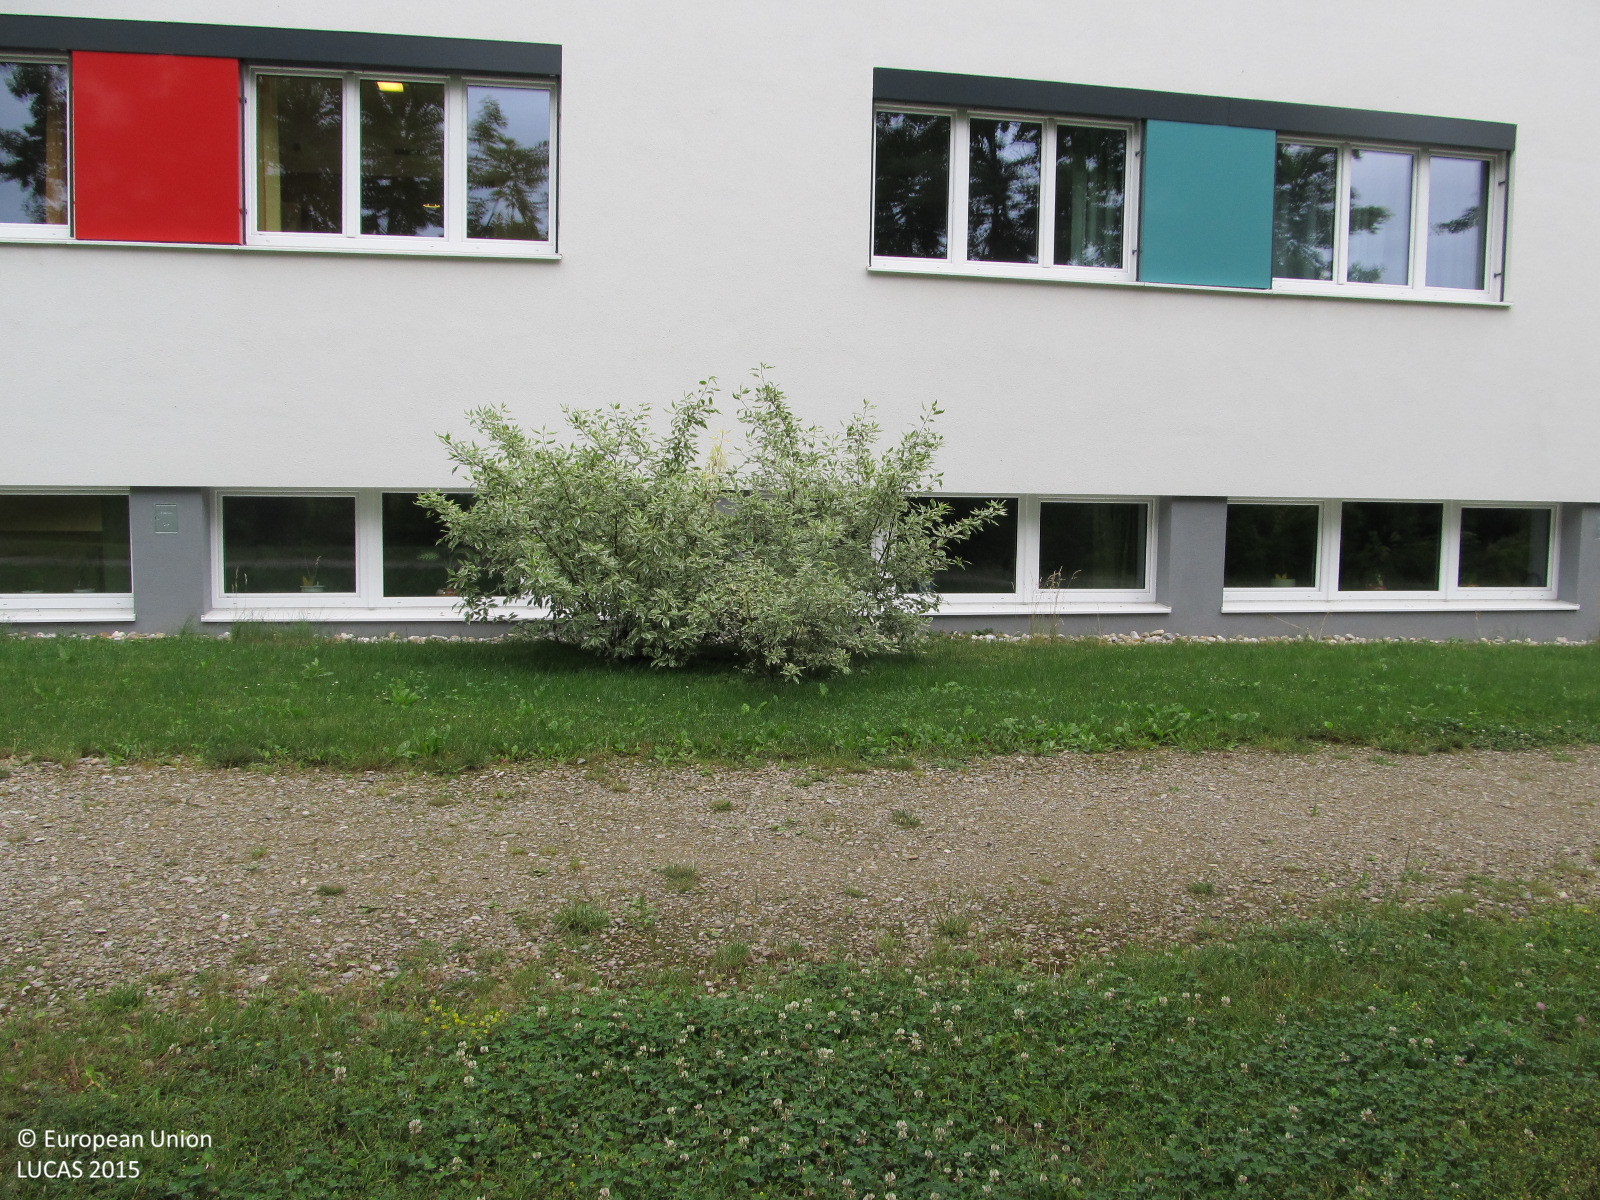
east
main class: Woodland
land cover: Broadleaved woodland
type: hemiboreal forest and nemoral coniferous forest and mixed broadleaved-coniferous forest
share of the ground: > 75 %
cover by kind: broadleaved forest trees 80 %, shrubs 20 %
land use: Forestry
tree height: < 5 m
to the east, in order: Broadleaved woodland; Spontaneously vegetated surfaces; Tracks; Railways; Shrubland without tree cover; Broadleaved woodland; Artificial constructions in urban areas; Broadleaved woodland; Artificial constructions in urban areas
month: June
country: AT
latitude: 48.2068
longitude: 15.6139
